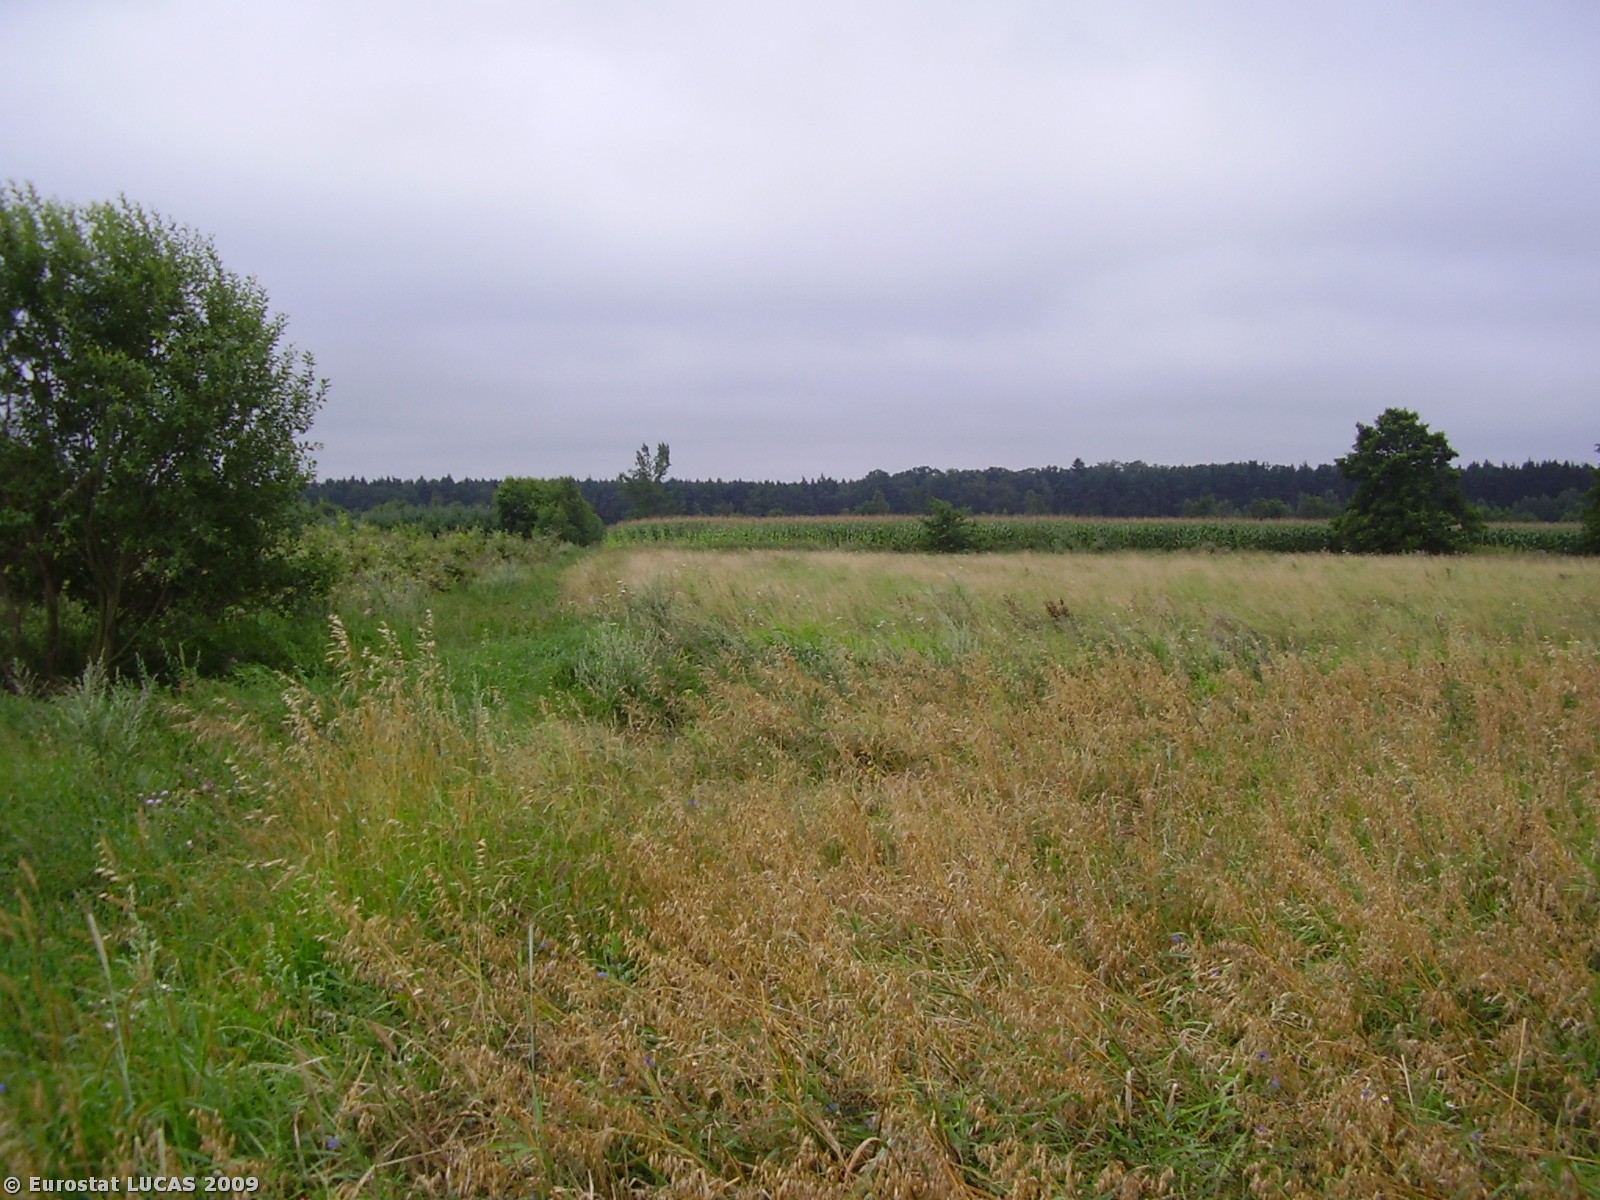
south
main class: Grassland
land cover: Spontaneously vegetated surfaces
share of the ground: > 75 %
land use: Fallow land
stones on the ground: < 10 %
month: April
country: PL
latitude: 51.5314
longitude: 16.8278
